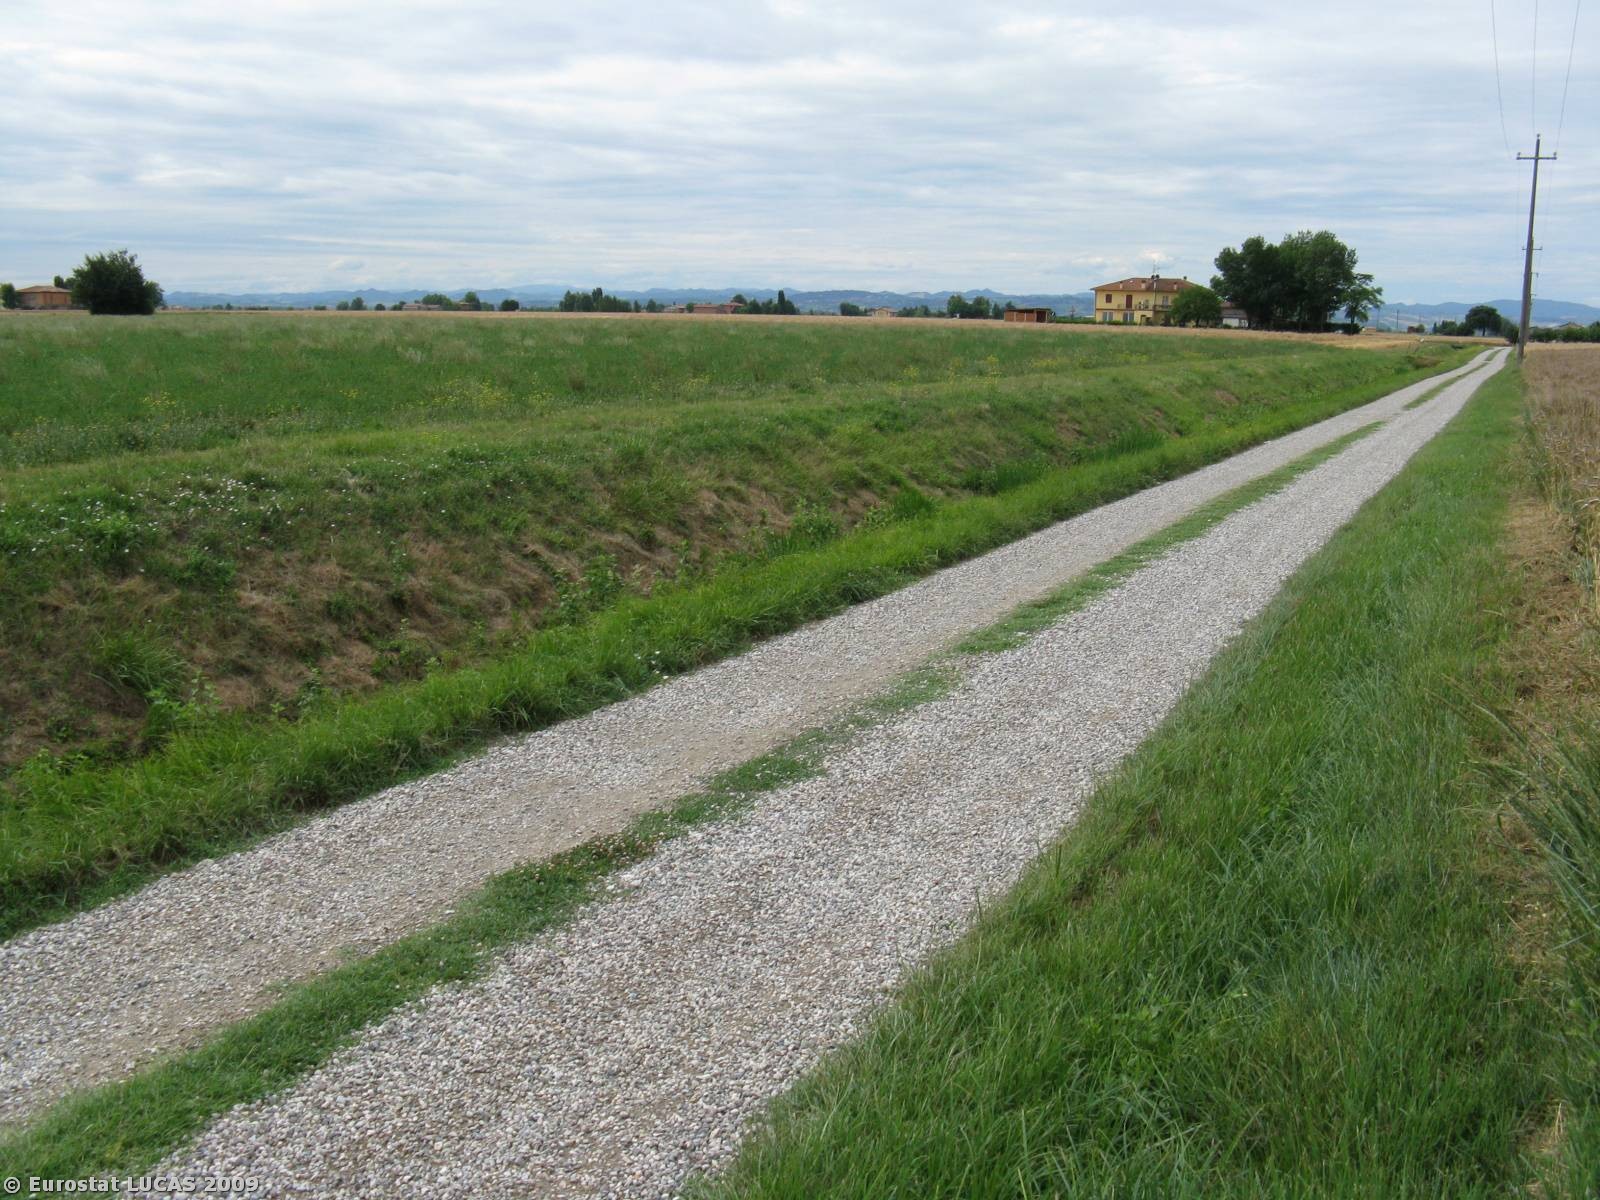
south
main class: Cropland
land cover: Durum wheat
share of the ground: > 75 %
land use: Agriculture (excluding fallow land and kitchen gardens)
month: June
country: IT
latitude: 44.4638
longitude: 11.6430
